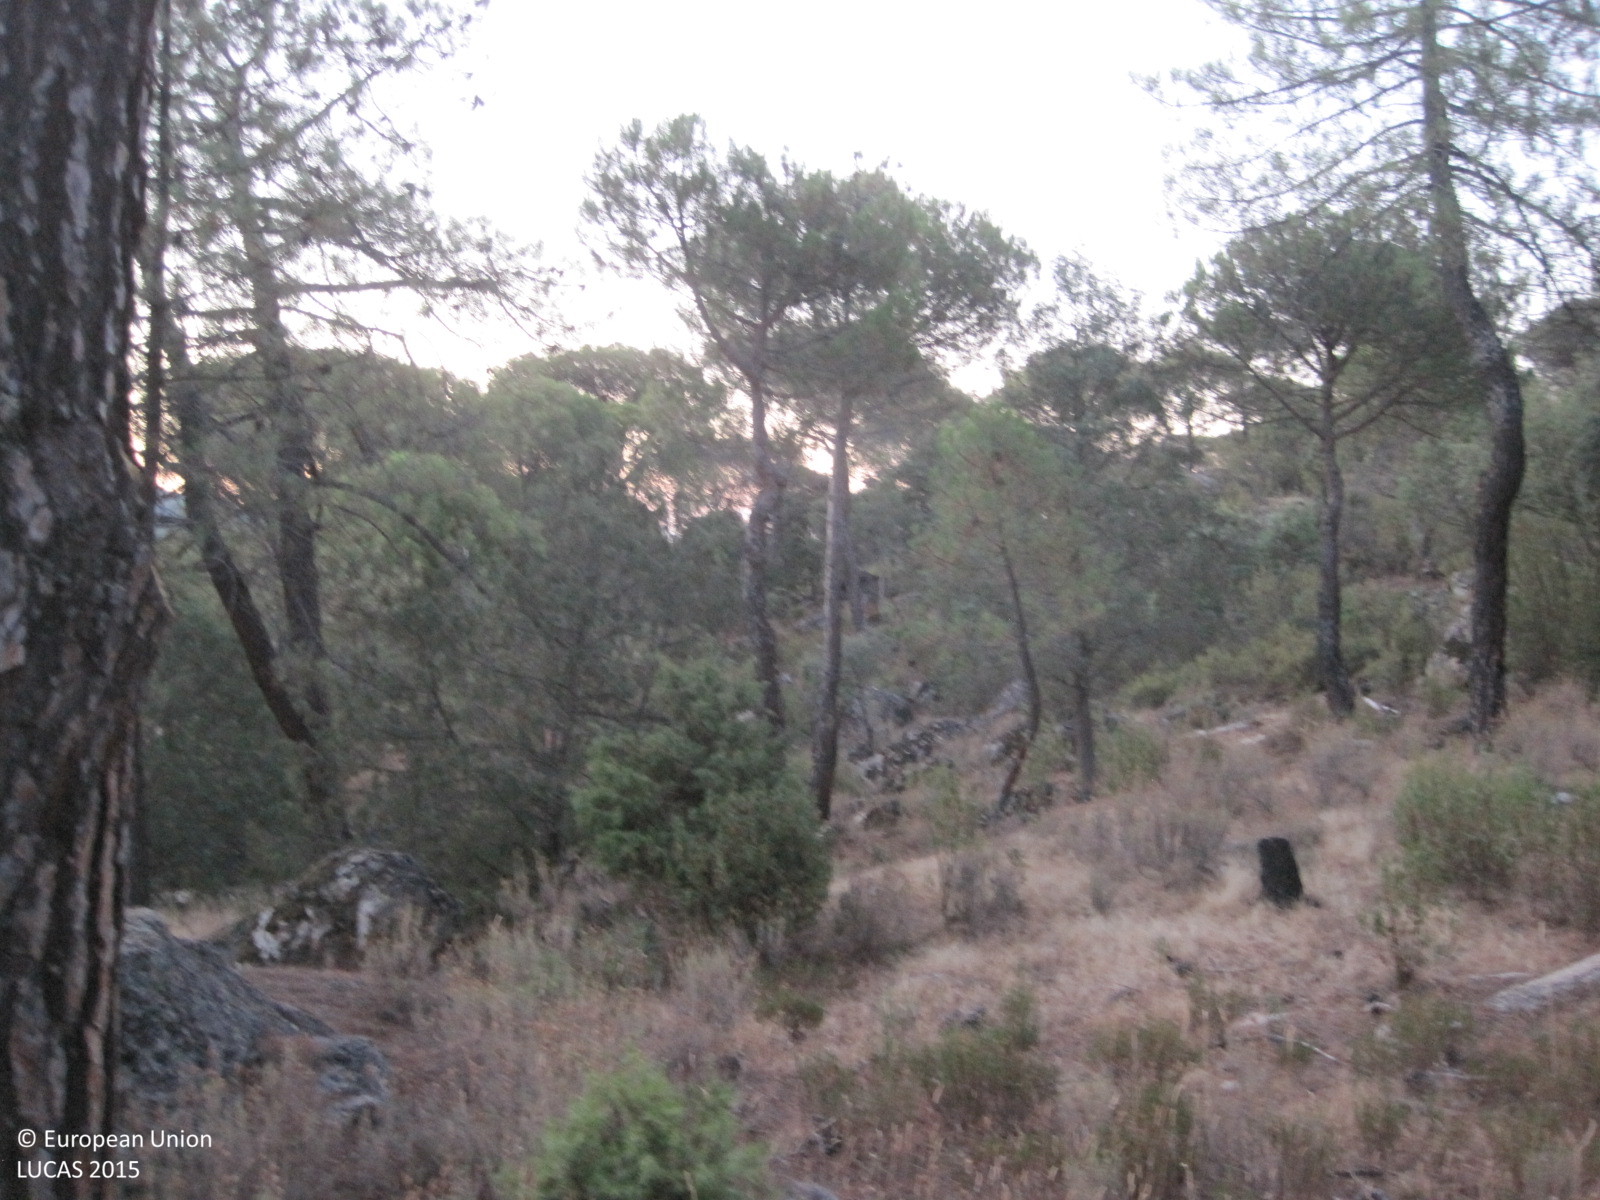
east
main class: Woodland
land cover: Pine dominated coniferous woodland
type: coniferous forest of the mediterranean region
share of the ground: > 75 %
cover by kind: coniferous forest trees 80 %, shrubs 20 %
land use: Forestry
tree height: > 5 m
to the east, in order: Pine dominated coniferous woodland; Rock outcrops; Pine dominated coniferous woodland; Tracks; Pine dominated coniferous woodland
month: July
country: ES
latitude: 40.3190
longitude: -4.3915
